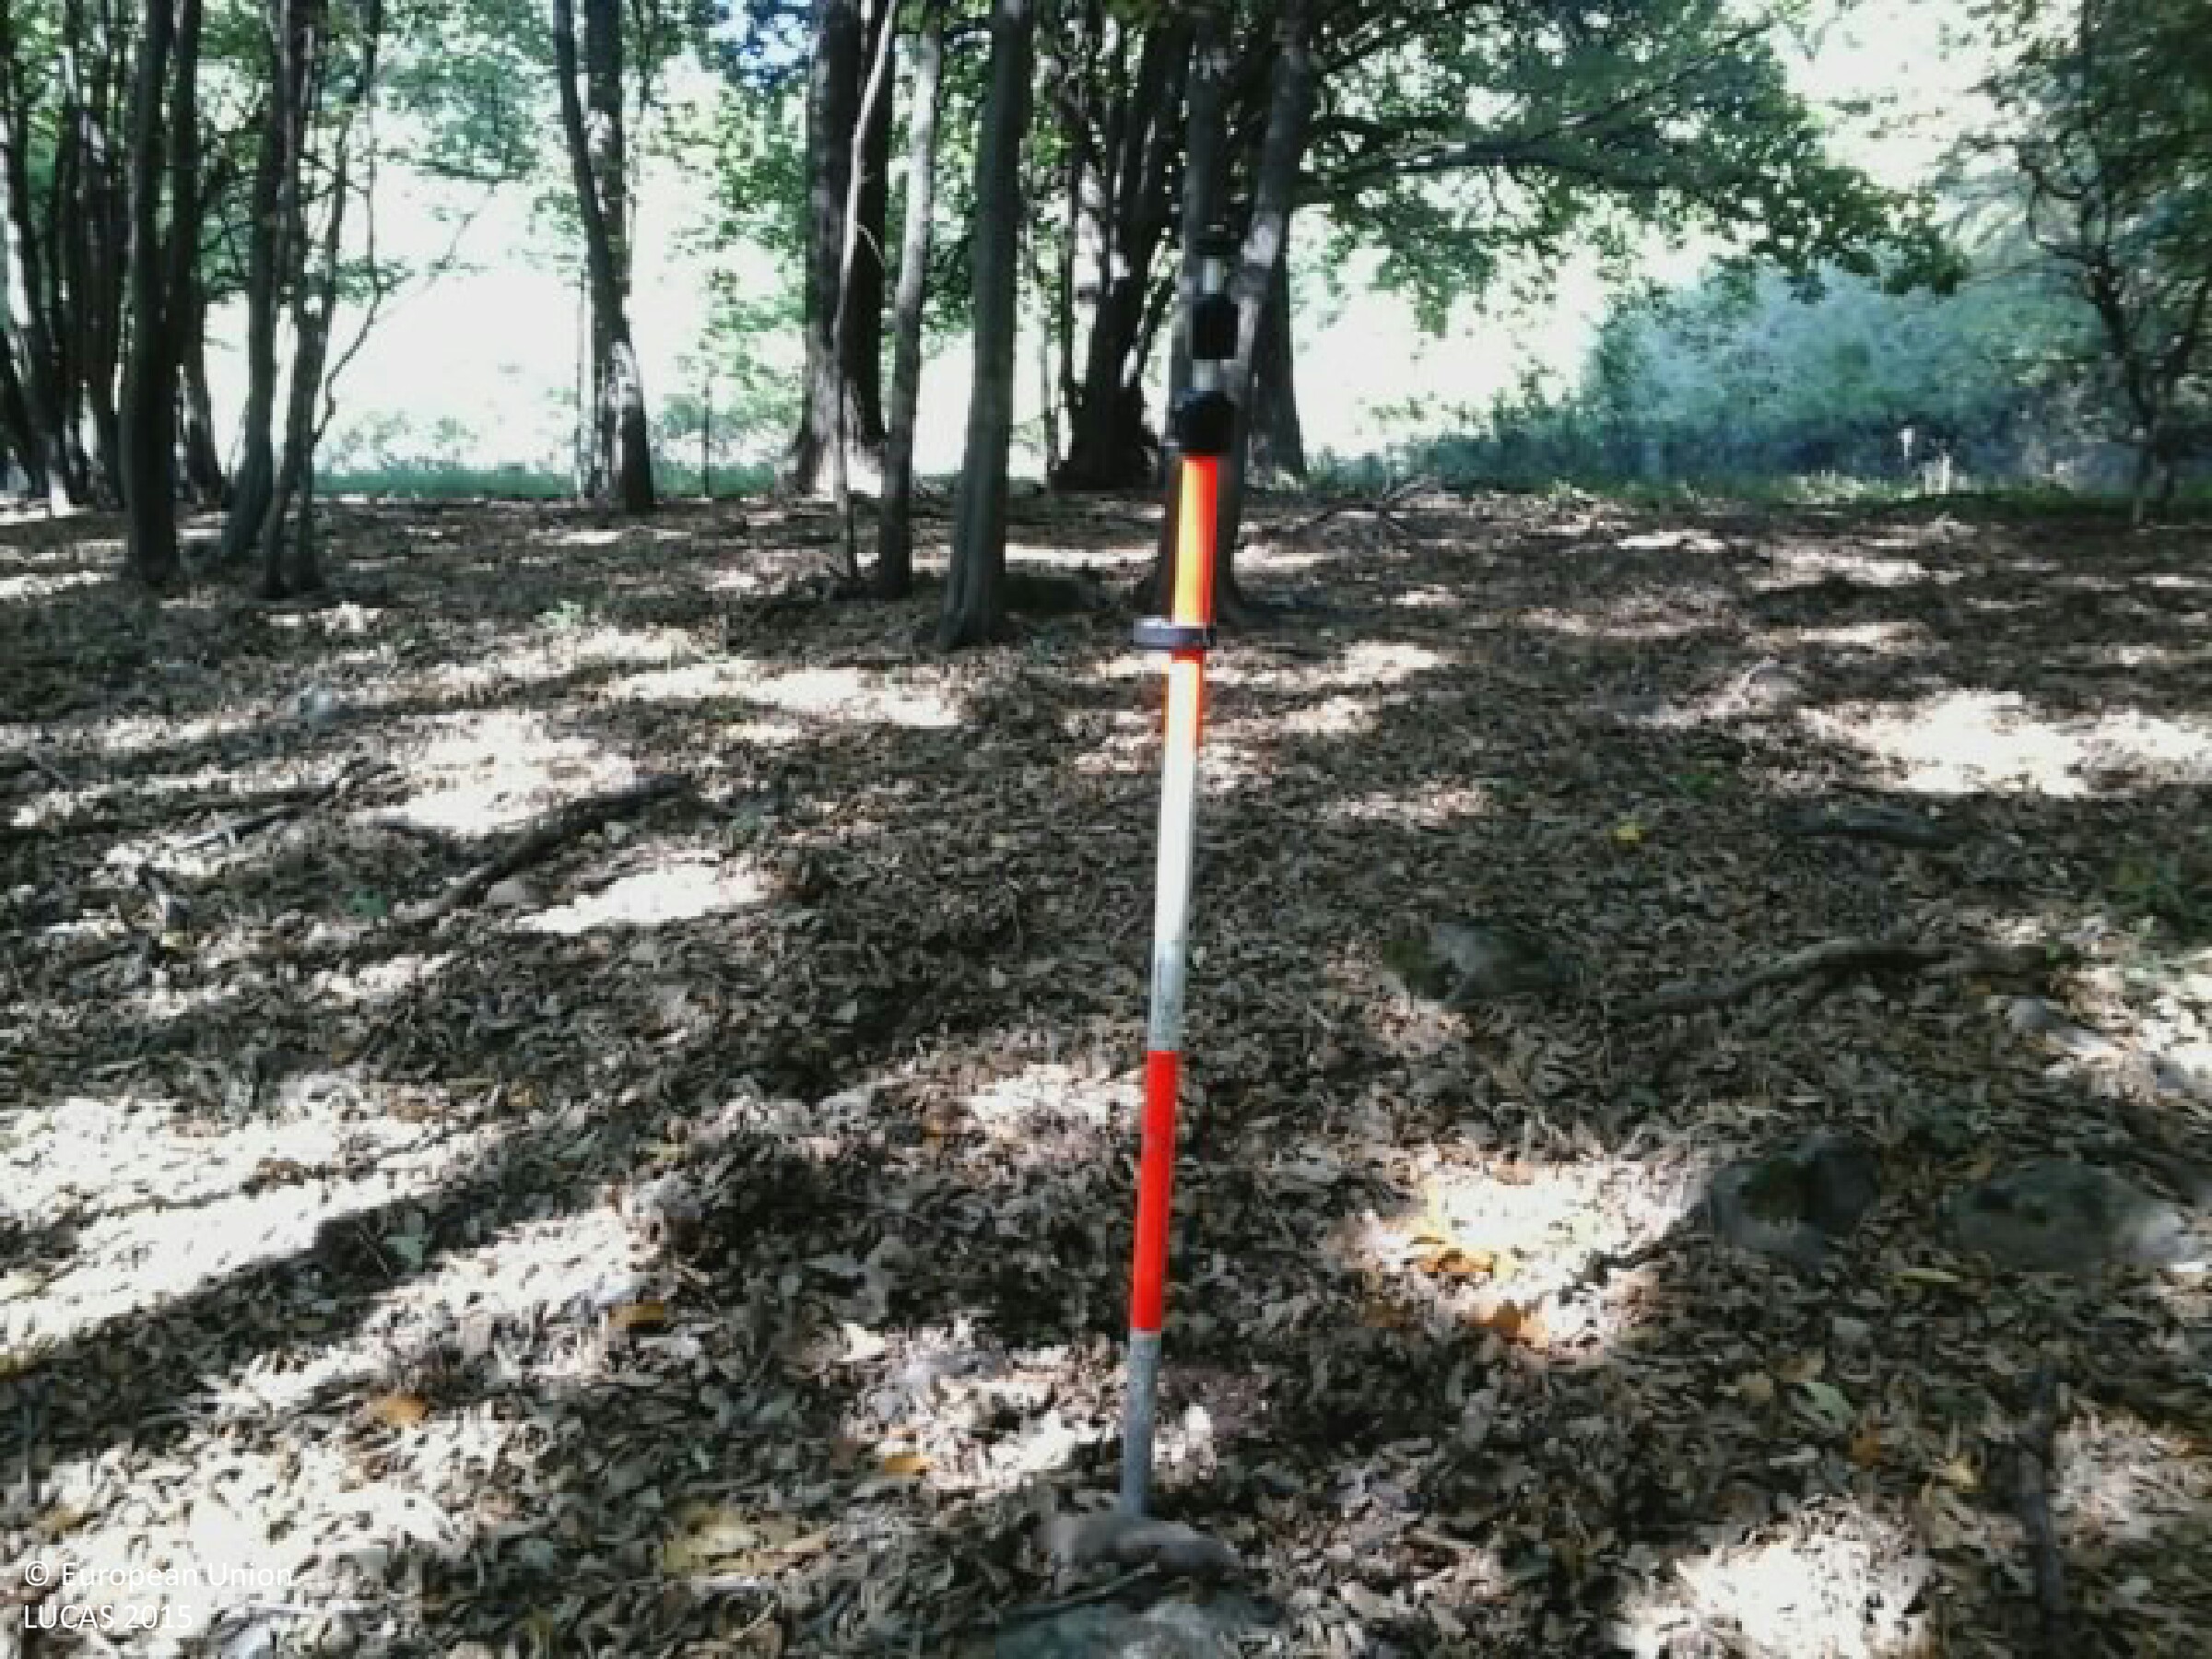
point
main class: Woodland
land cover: Broadleaved woodland
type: beech forest
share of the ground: > 75 %
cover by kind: broadleaved forest trees 100 %
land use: Forestry
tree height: > 5 m
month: September
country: HU
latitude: 47.8896
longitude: 19.8562
